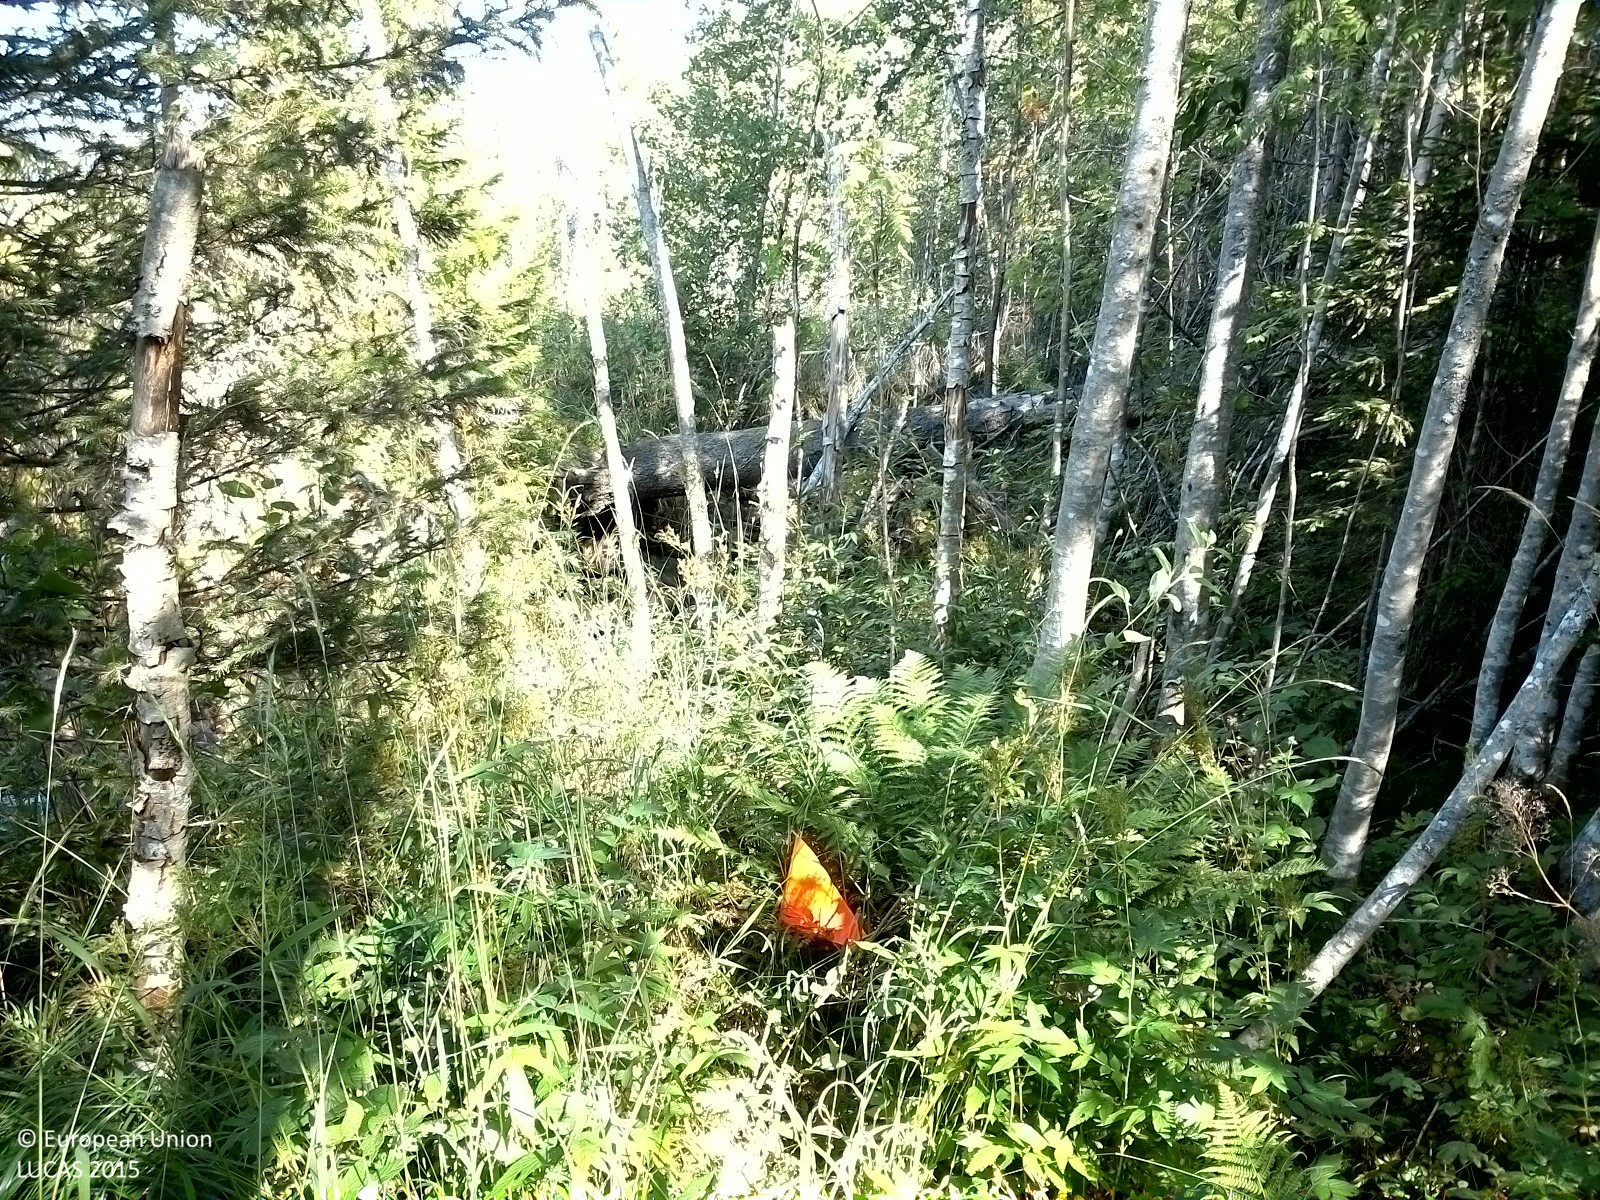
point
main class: Woodland
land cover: Broadleaved woodland
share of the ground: 25 - 50 %
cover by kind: broadleaved forest trees 40 %, shrubs 40 %, herbaceous plants 20 %
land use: Forestry
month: August
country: SE
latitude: 62.3698
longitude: 16.7643
